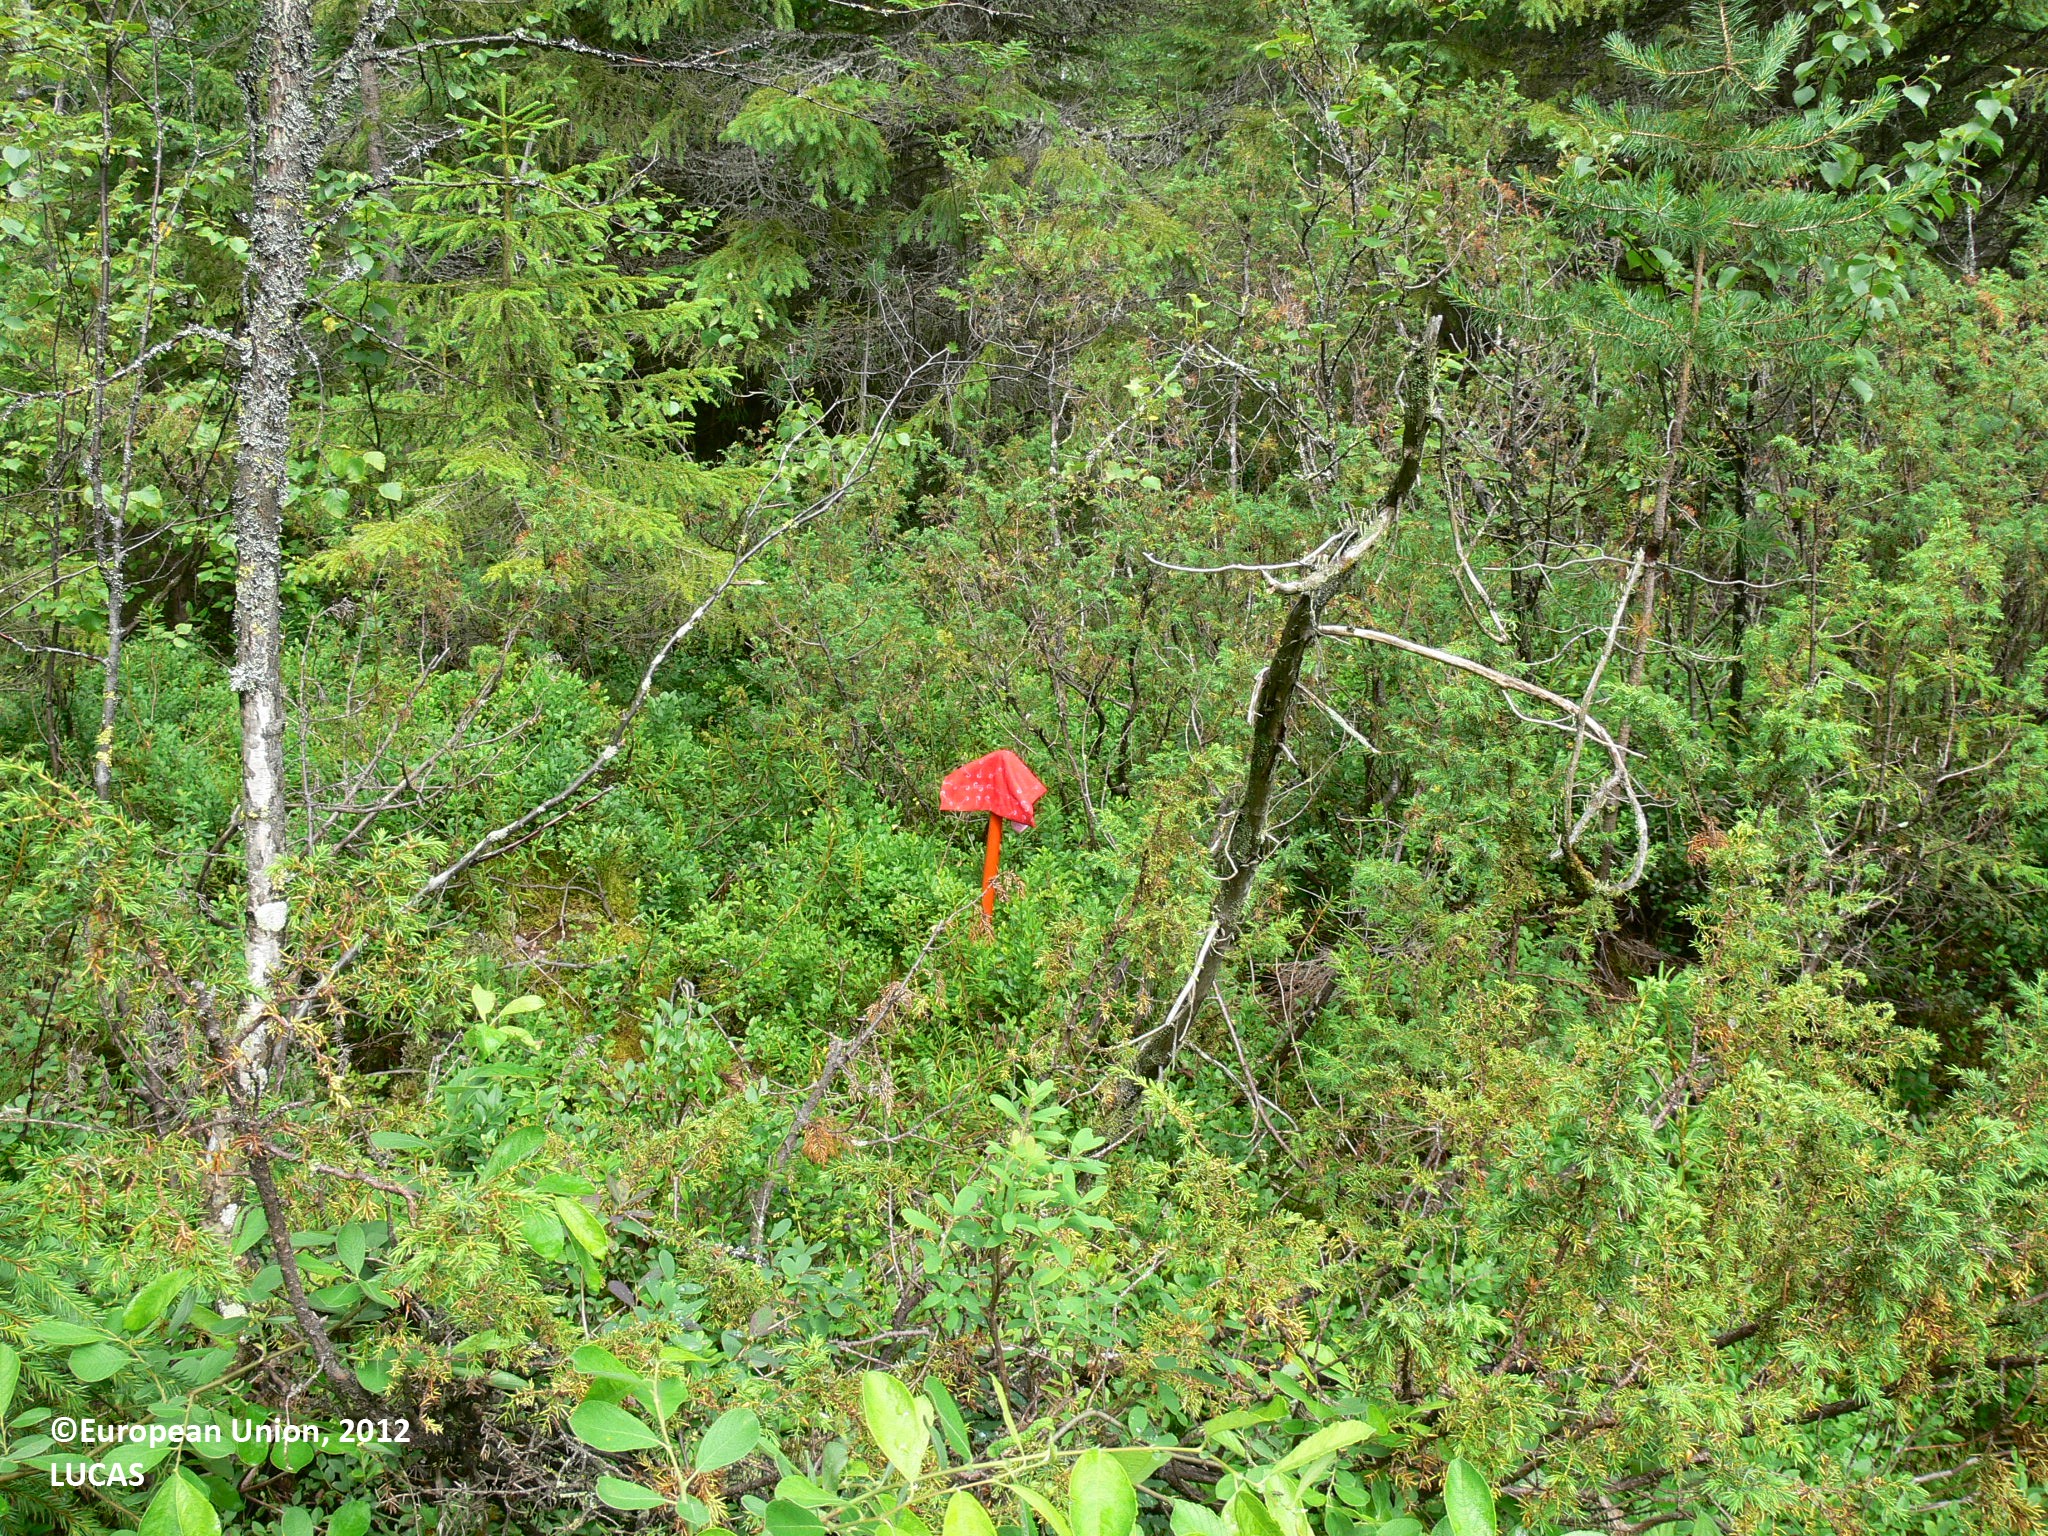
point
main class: Woodland
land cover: Spruce dominated coniferous woodland
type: boreal forest
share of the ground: 50 - 75 %
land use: Forestry
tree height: > 5 m
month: July
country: FI
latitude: 63.0872
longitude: 29.5418
